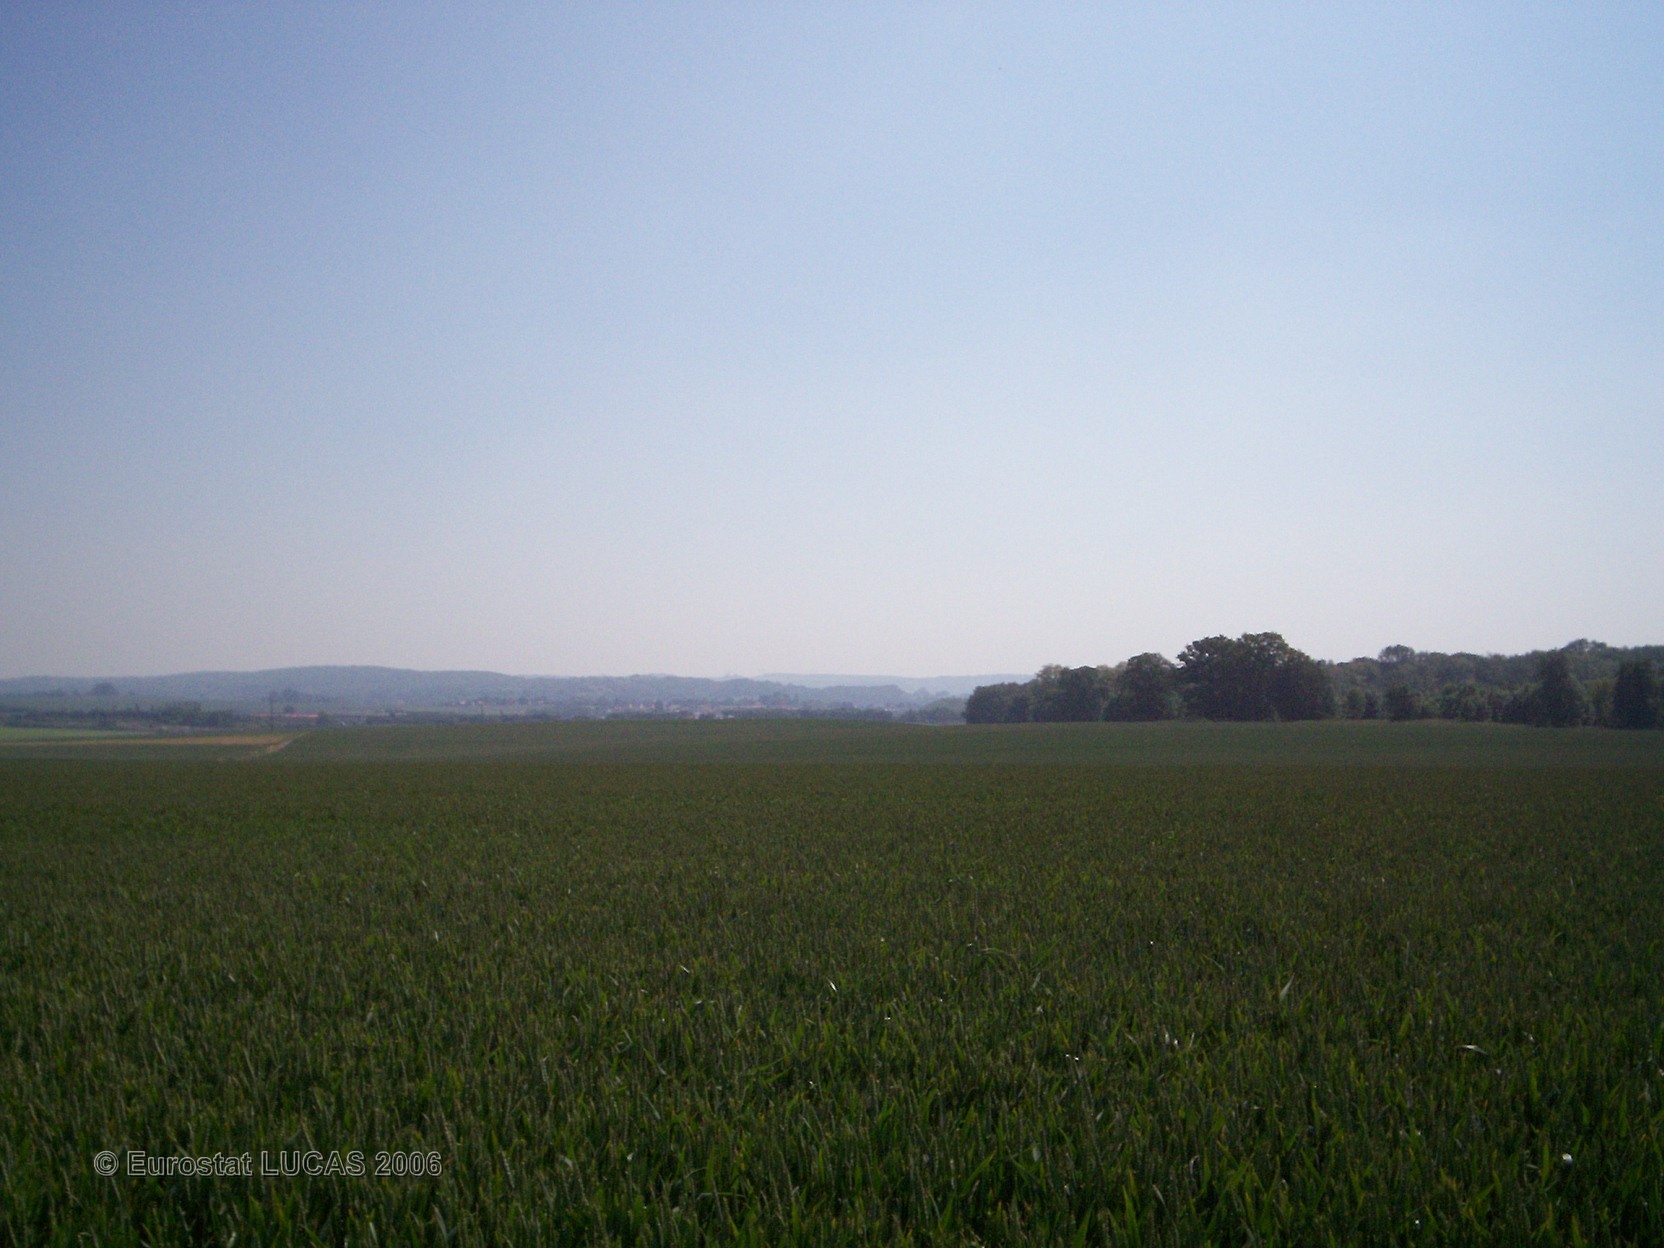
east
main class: Cropland
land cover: Common wheat
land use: Agriculture (excluding fallow land and kitchen gardens)
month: June
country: FR
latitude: 49.5352
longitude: 2.7070
